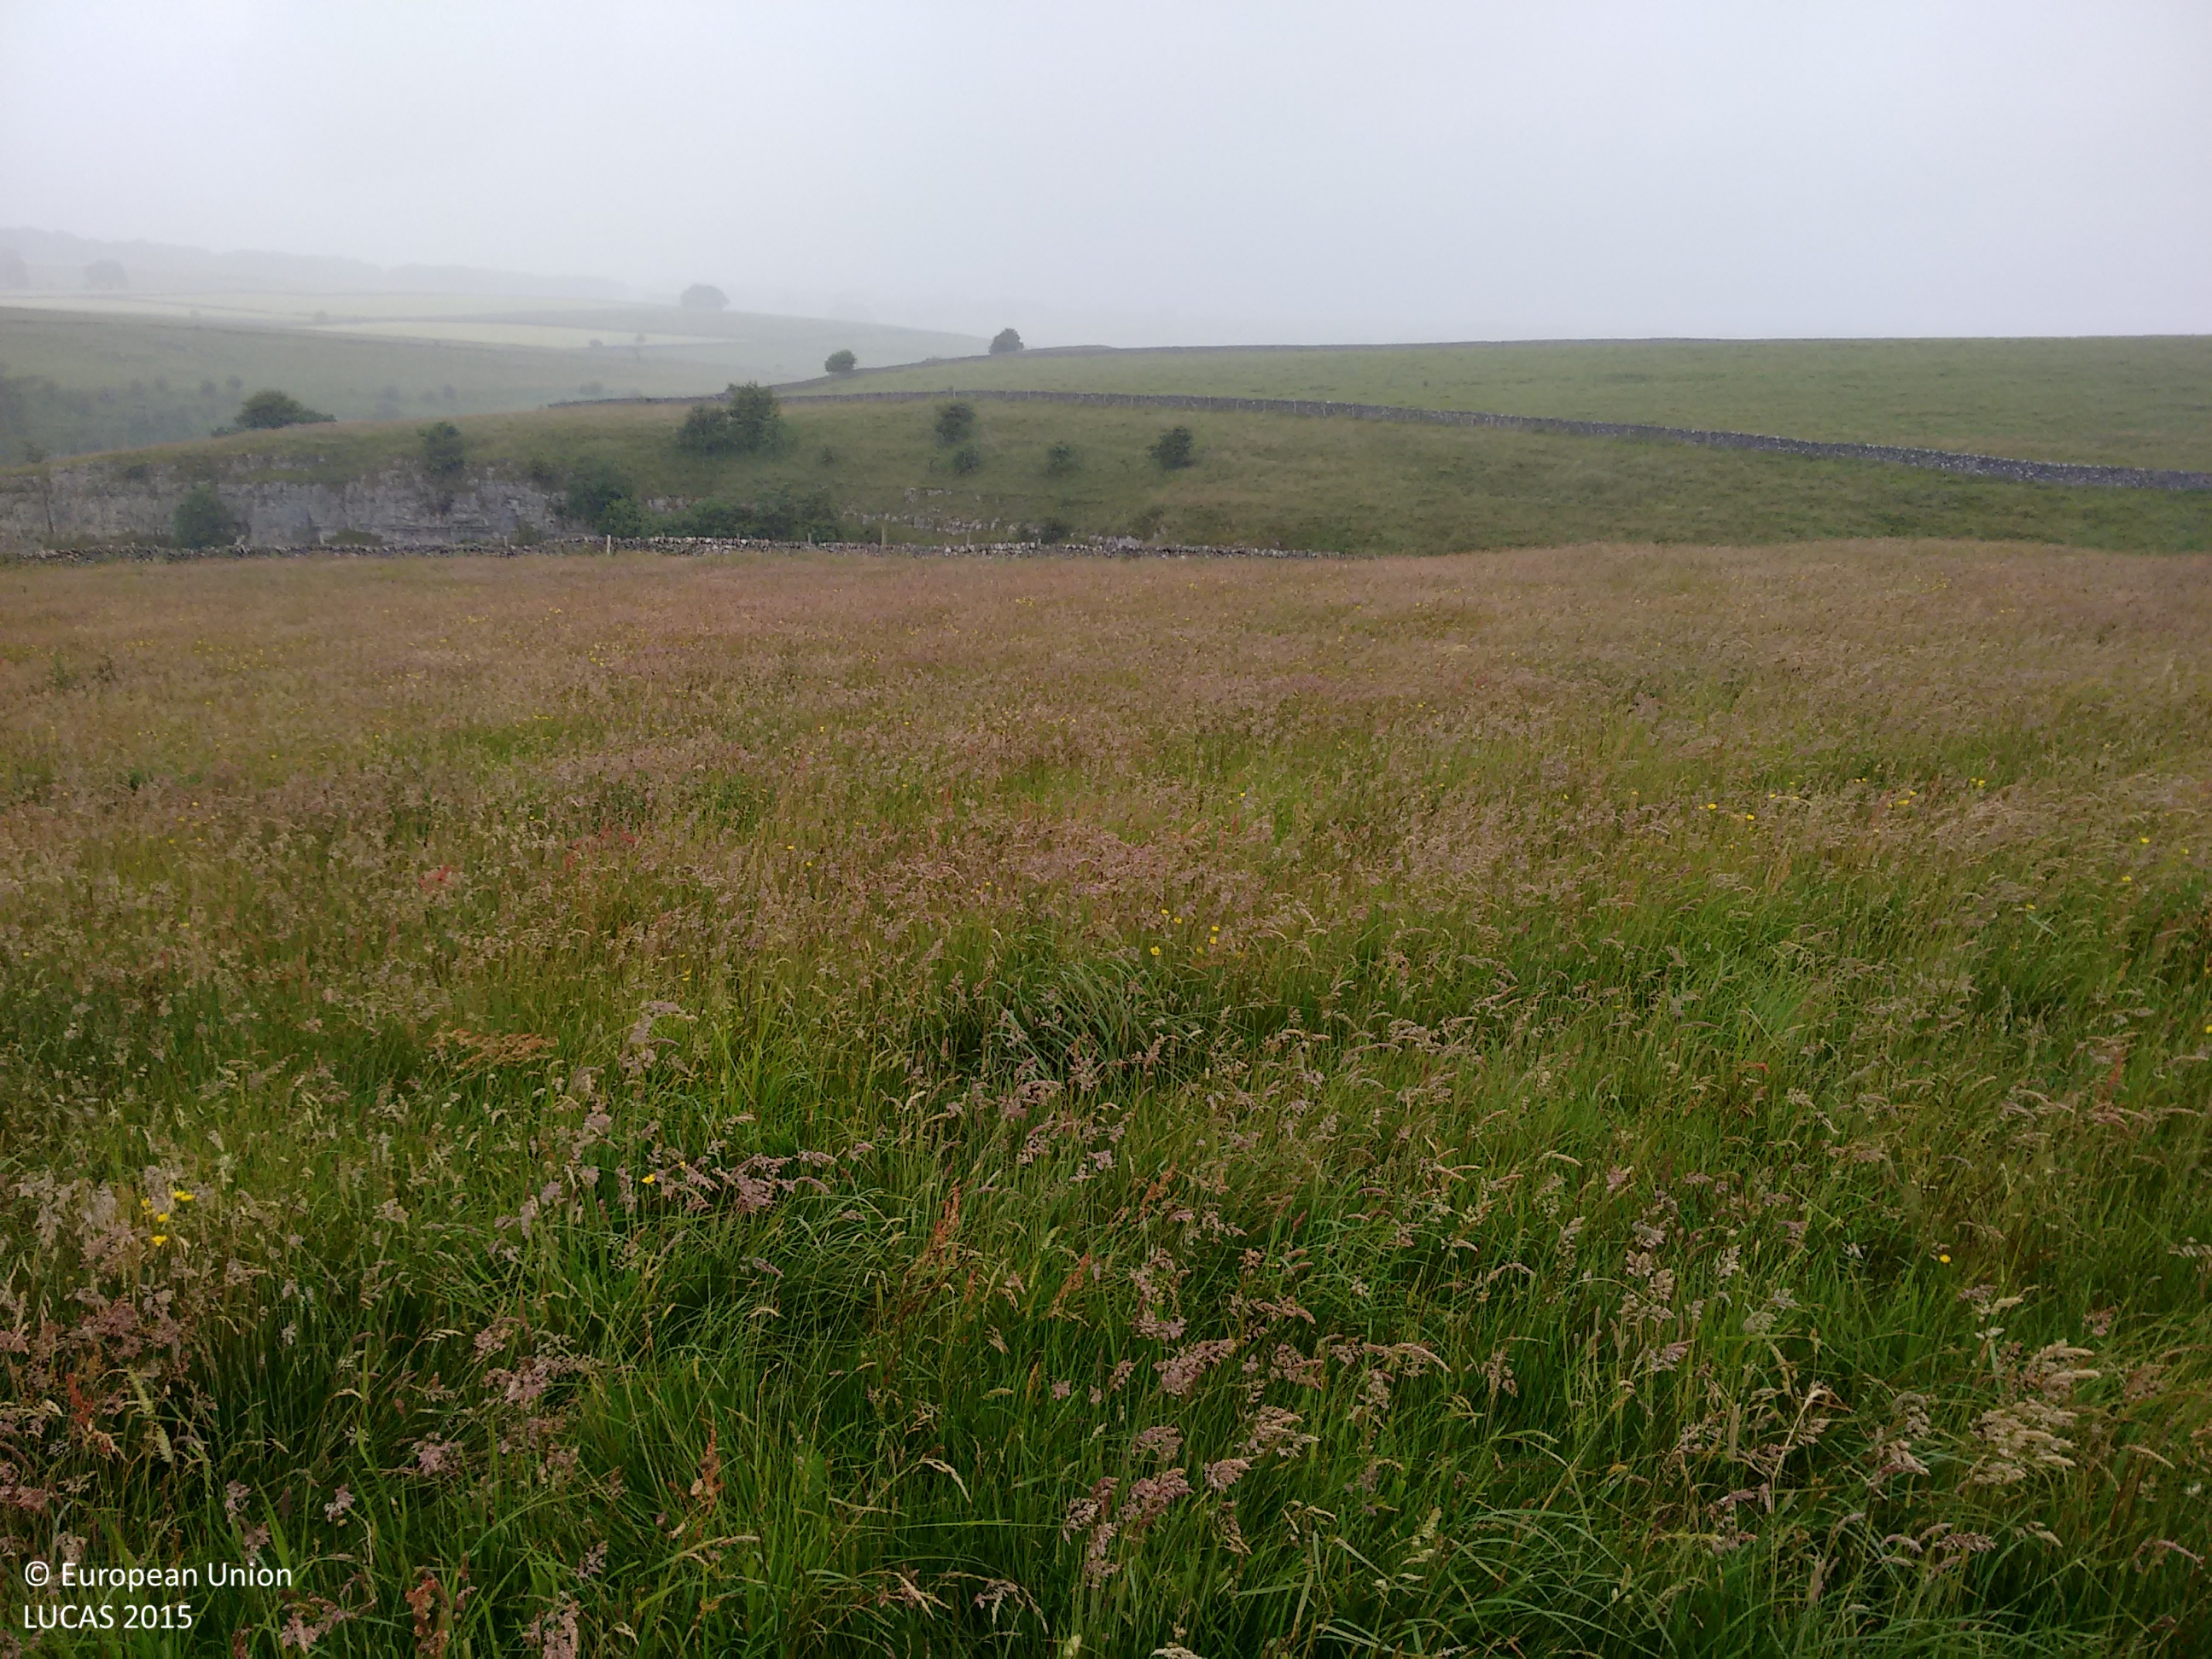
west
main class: Grassland
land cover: Grassland without tree/shrub cover
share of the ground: > 75 %
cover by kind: herbaceous plants 100 %
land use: Agriculture (excluding fallow land and kitchen gardens)
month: July
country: GB
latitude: 53.1917
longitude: -1.7432
